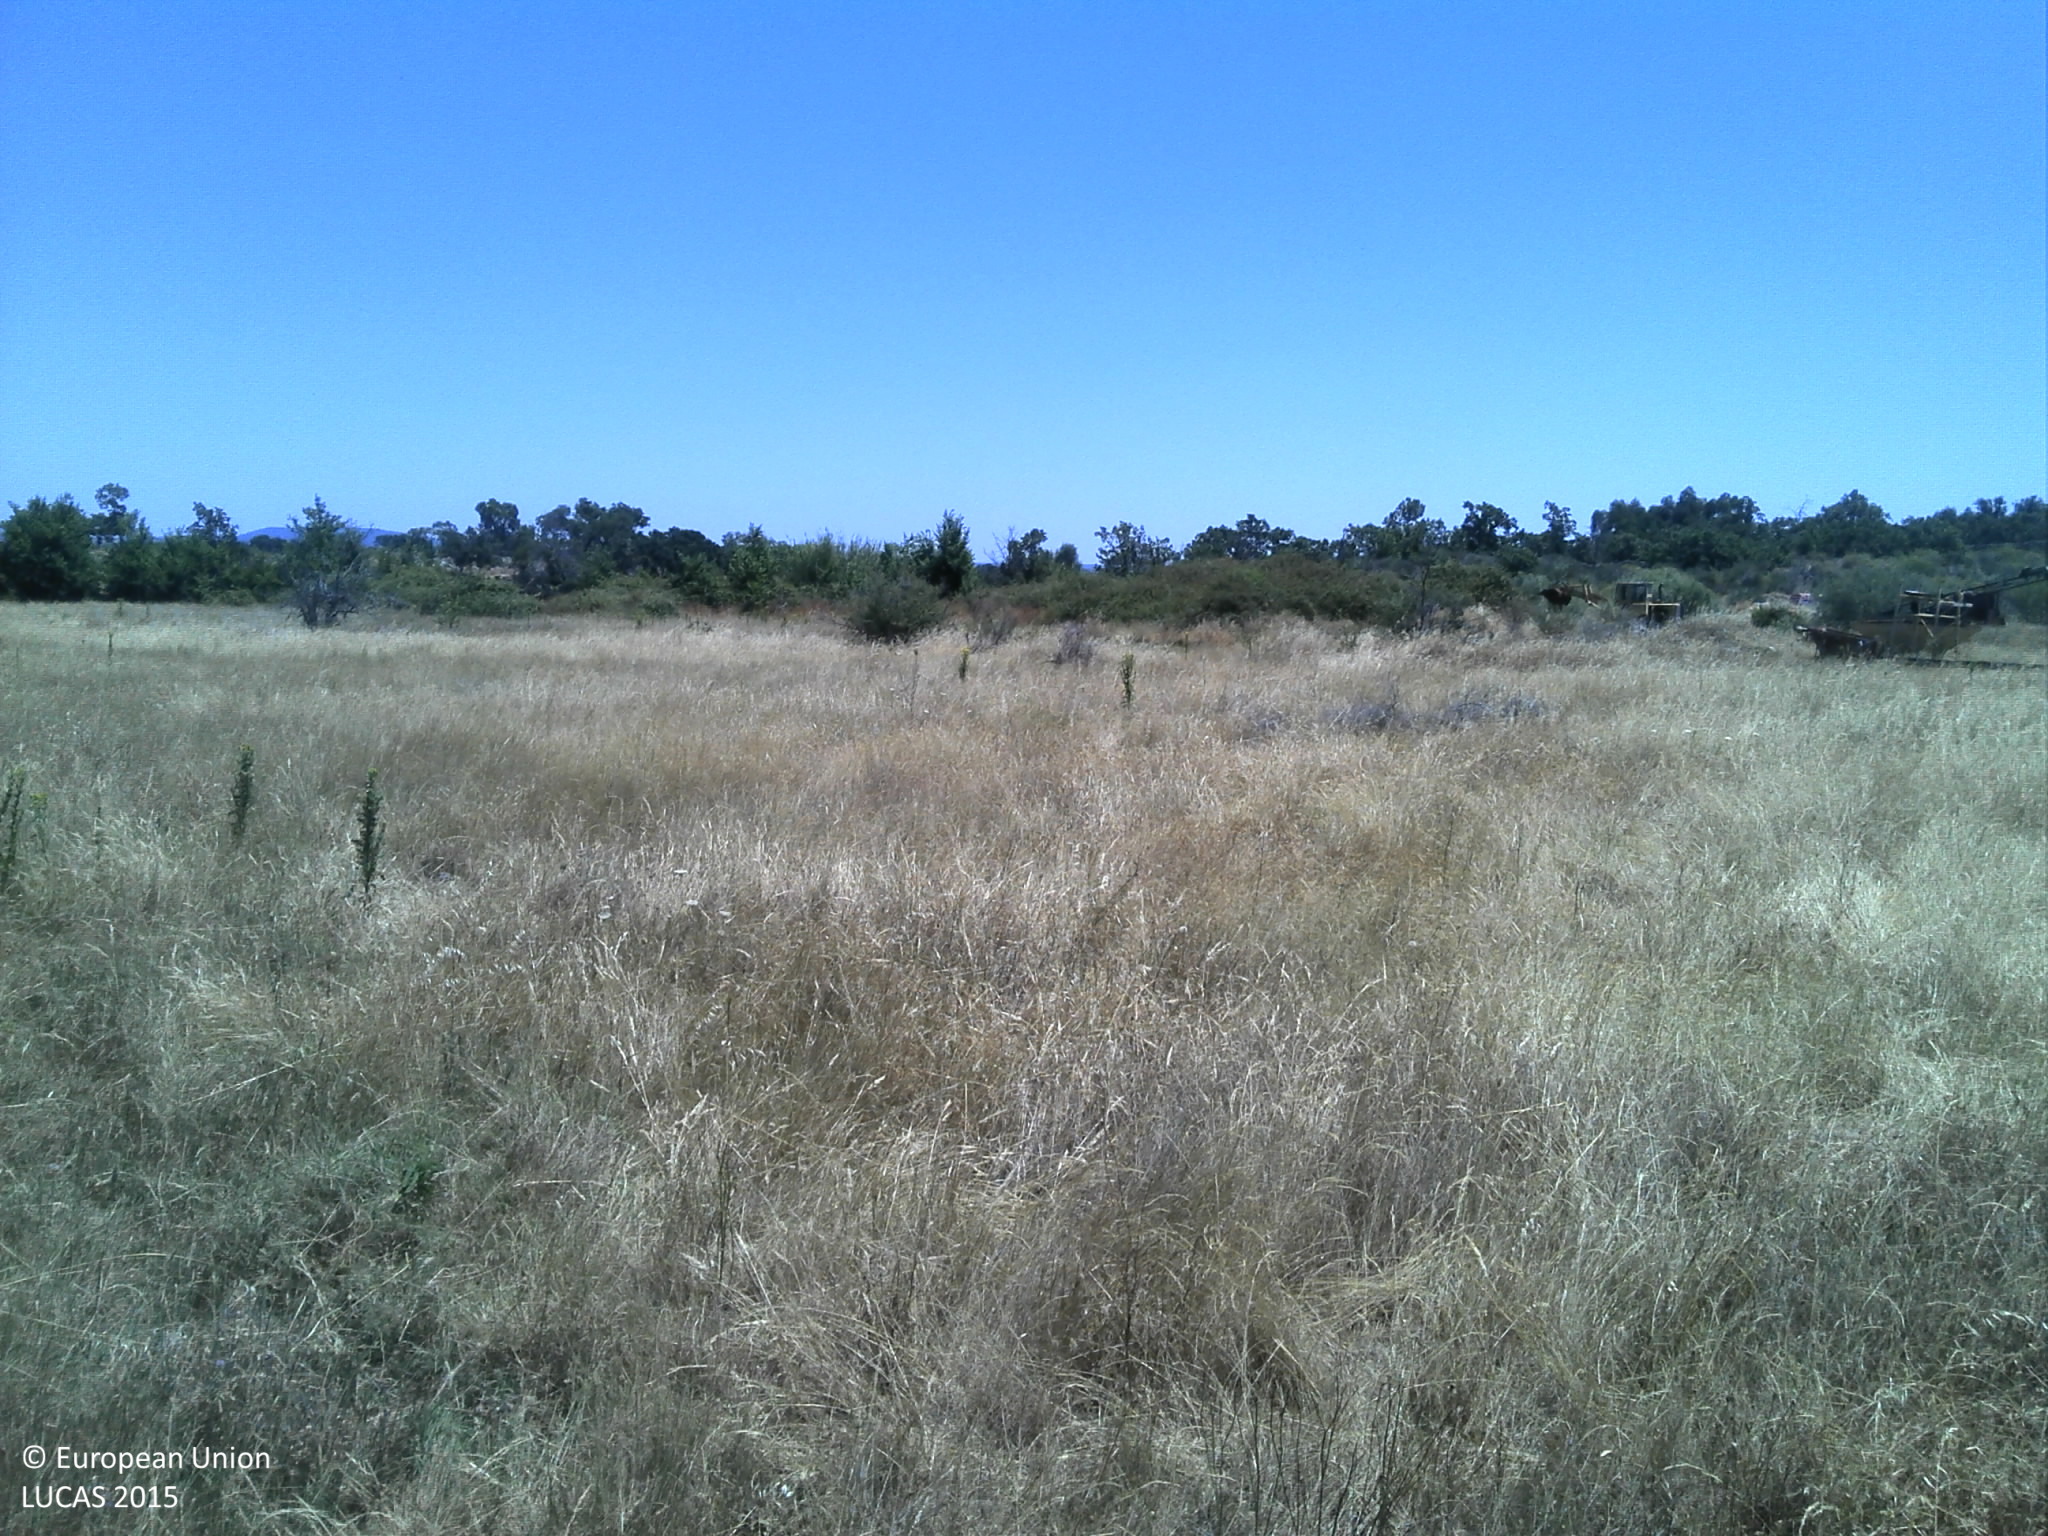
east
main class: Grassland
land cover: Grassland without tree/shrub cover
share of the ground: 50 - 75 %
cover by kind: herbaceous plants 75 %, unconsolidated bare surface 15 %
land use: Agriculture (excluding fallow land and kitchen gardens)
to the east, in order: Grassland without tree/shrub cover; Shrubland without tree cover; Dry stone walls; Fences; Spontaneously vegetated surfaces; Dry stone walls; Spontaneously vegetated surfaces; Rock outcrops; Spontaneously vegetated surfaces; Fences; Dry stone walls; Broadleaved woodland
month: June
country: PT
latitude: 39.9455
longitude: -7.2415
